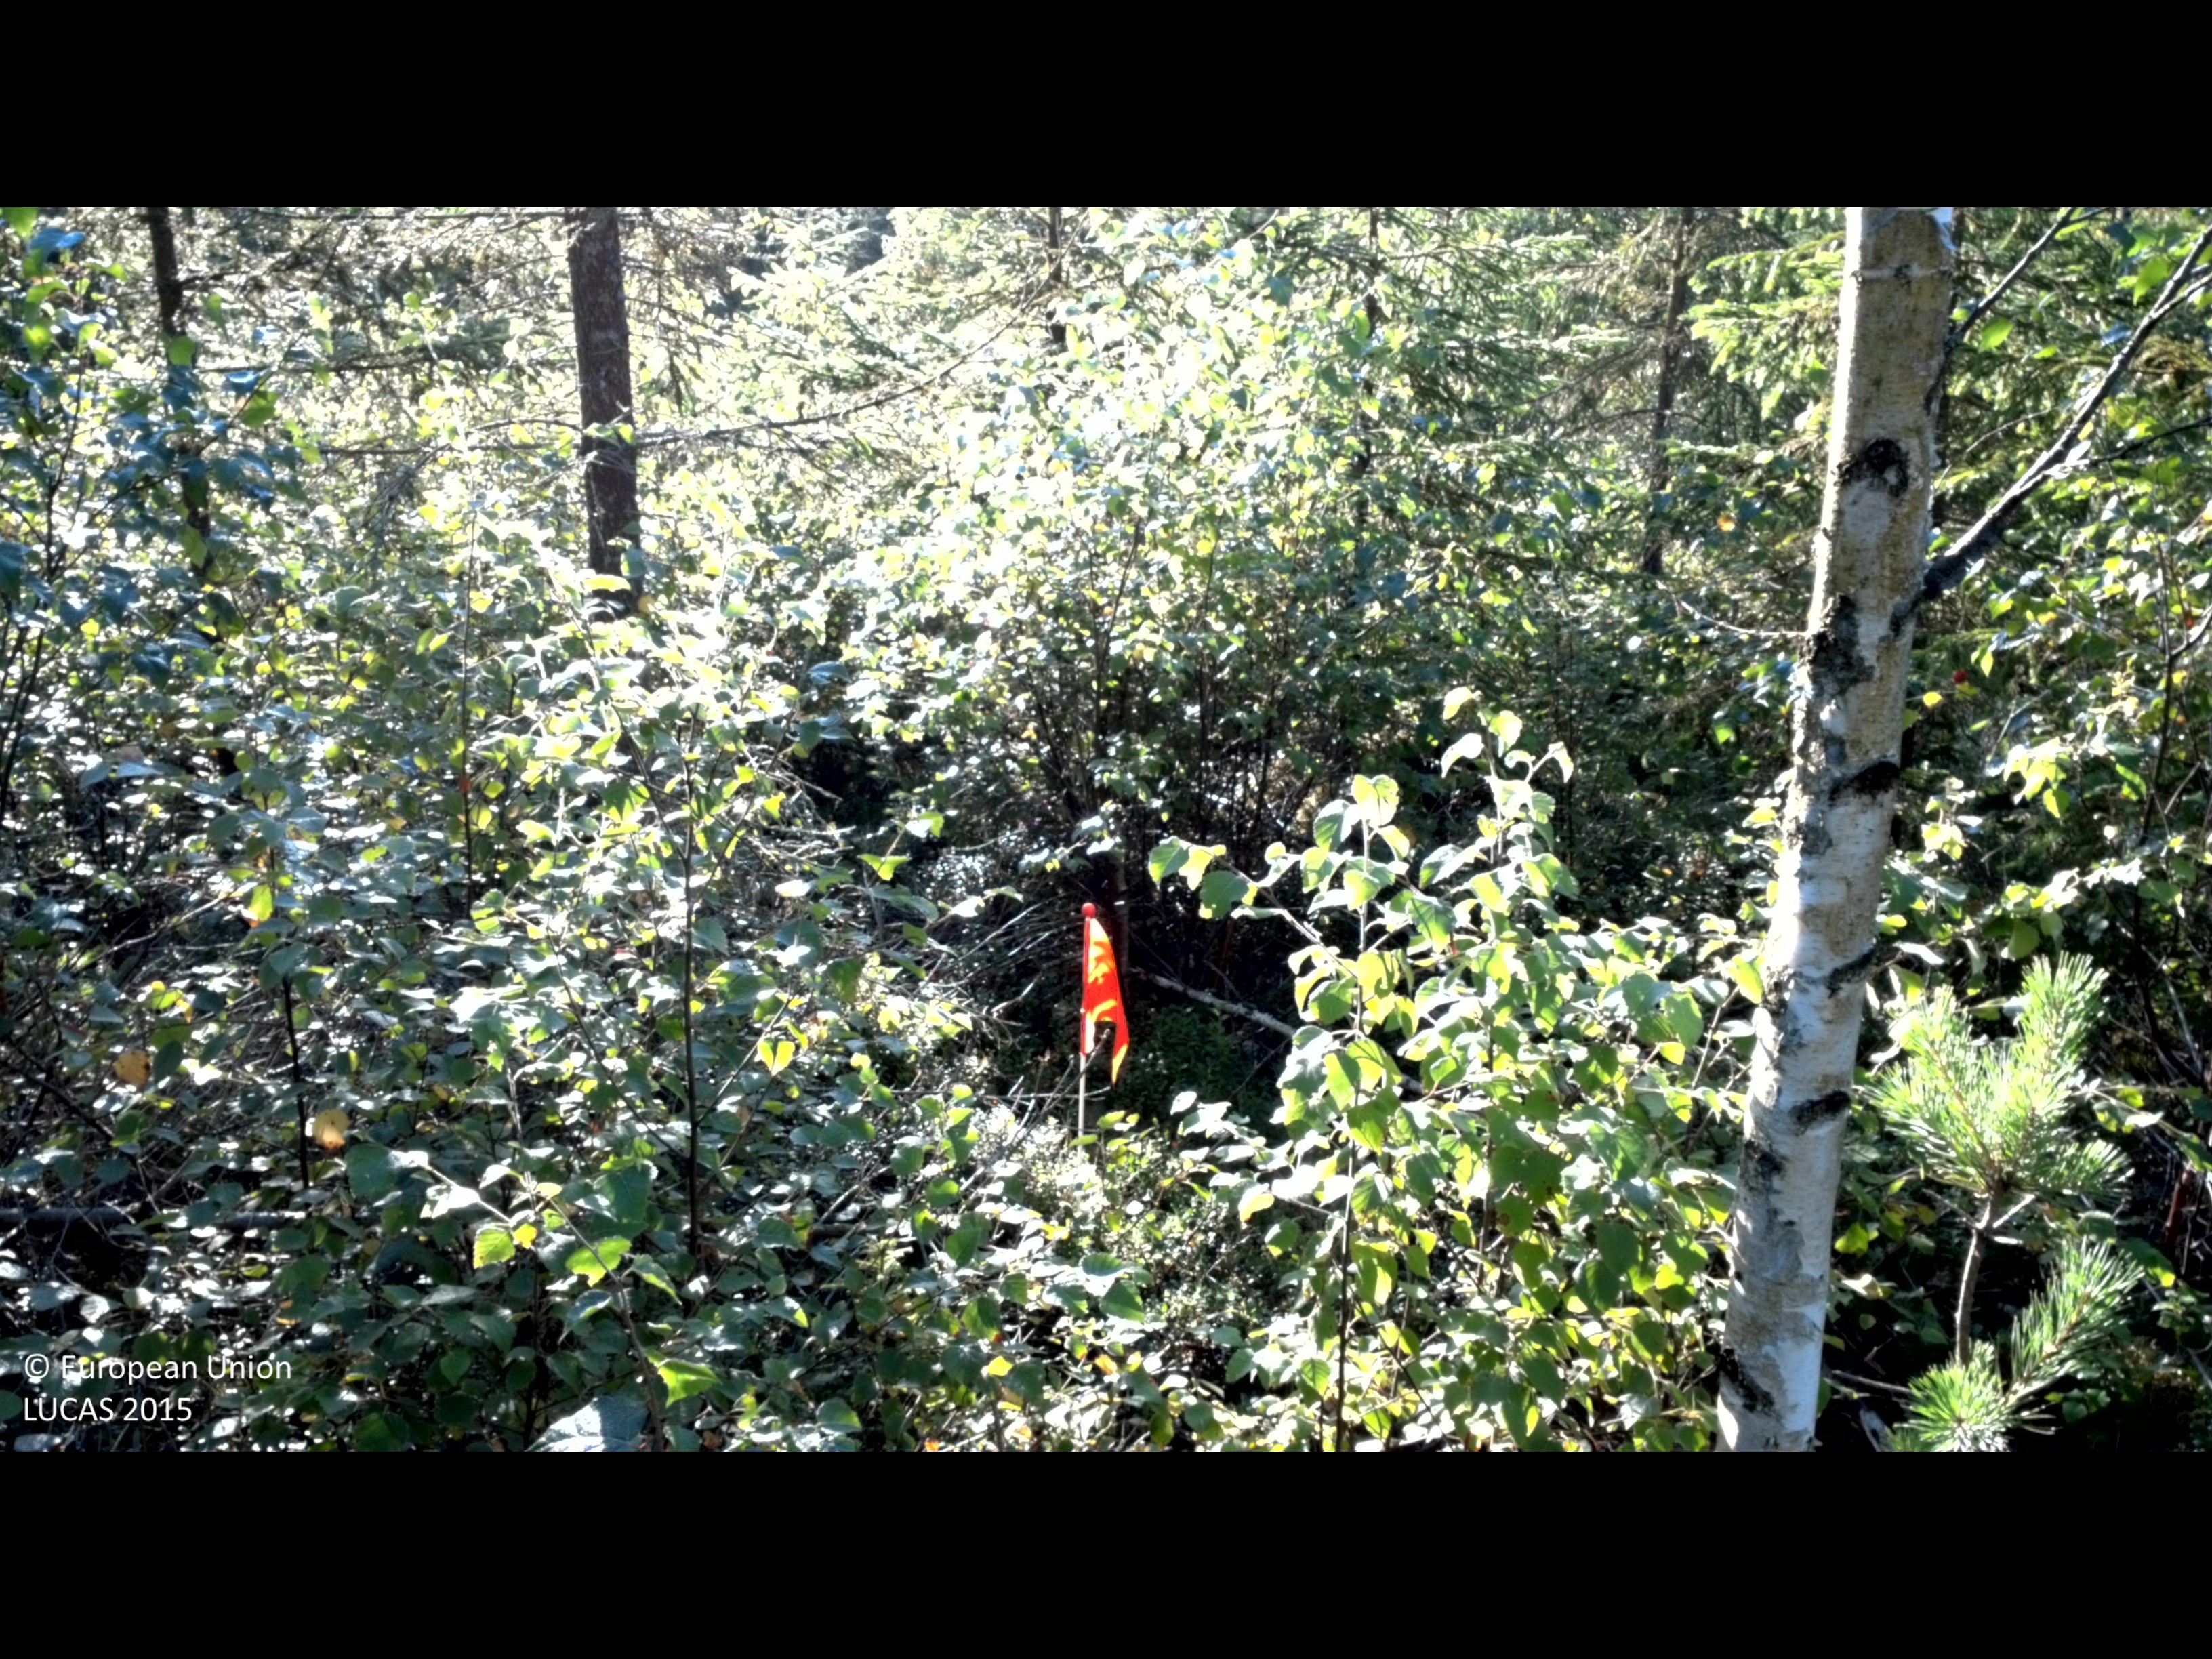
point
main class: Woodland
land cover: Spruce dominated mixed woodland
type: boreal forest
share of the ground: 50 - 75 %
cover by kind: coniferous forest trees 45 %, broadleaved forest trees 30 %, shrubs 25 %
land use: Forestry
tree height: > 5 m
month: August
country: SE
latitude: 56.9567
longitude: 13.2358
